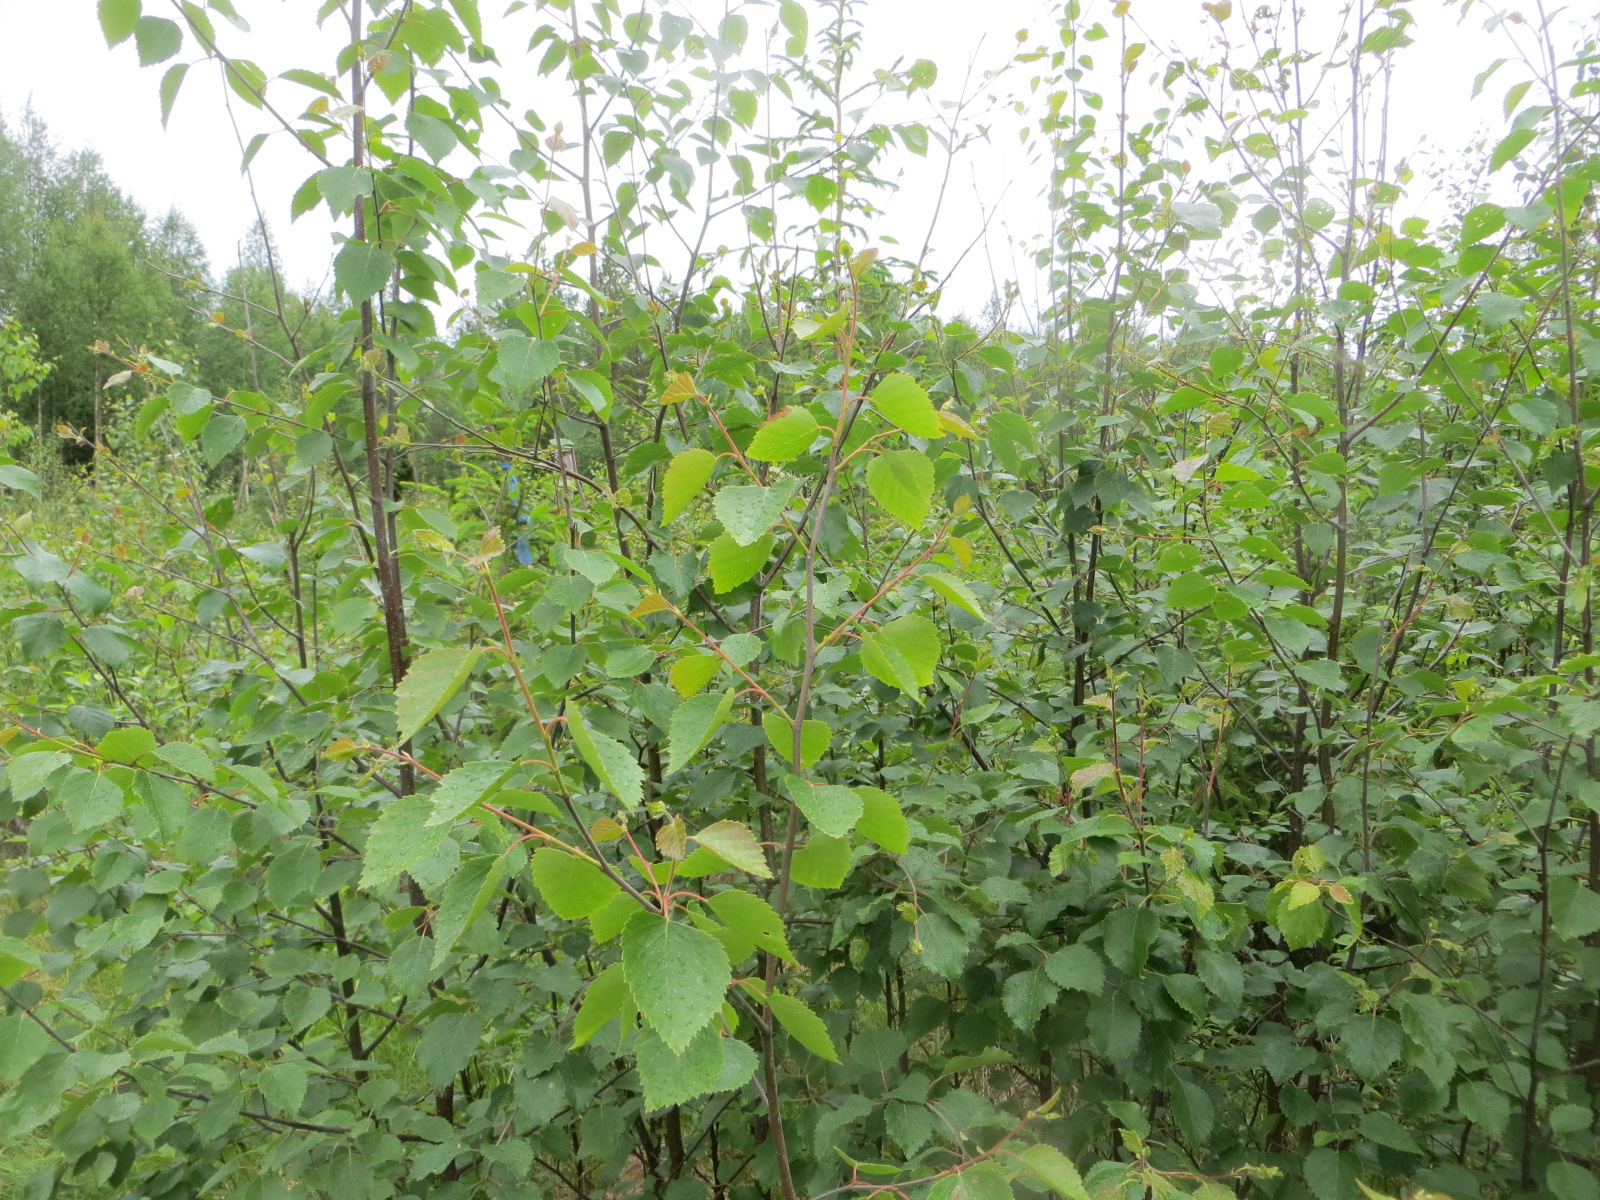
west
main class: Woodland
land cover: Broadleaved woodland
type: boreal forest
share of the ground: > 75 %
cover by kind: broadleaved forest trees 60 %, herbaceous plants 25 %, coniferous forest trees 15 %
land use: Forestry
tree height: < 5 m
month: June
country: FI
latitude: 65.6585
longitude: 26.6942
